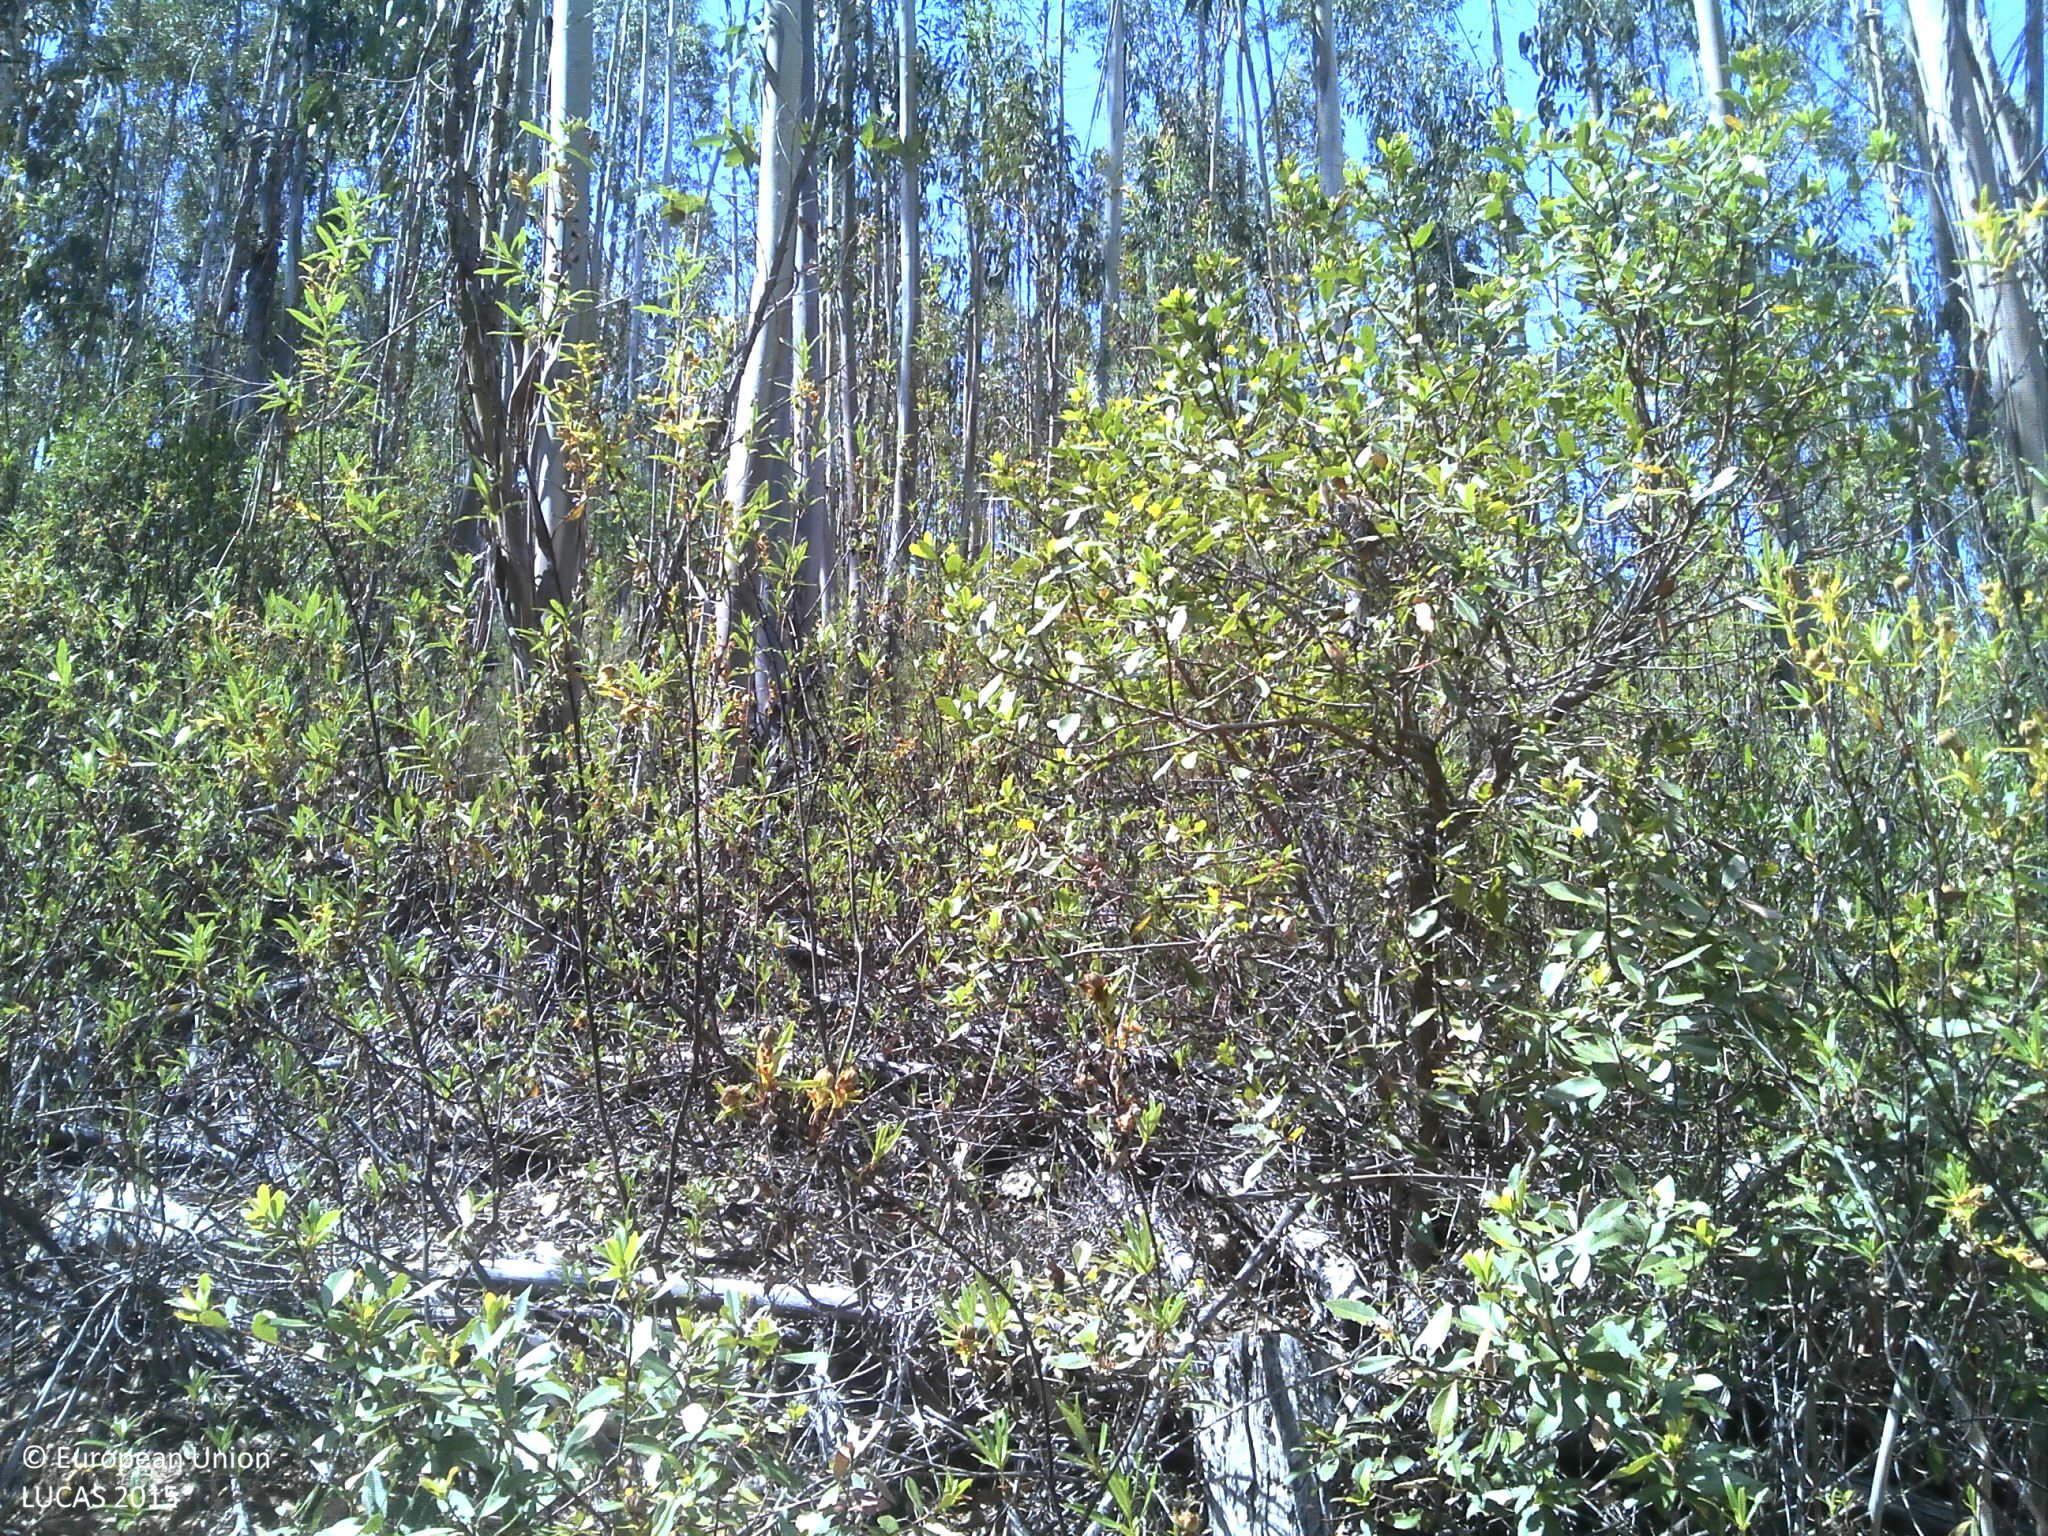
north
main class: Woodland
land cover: Broadleaved woodland
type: mesophytic deciduous forest
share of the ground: 50 - 75 %
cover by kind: broadleaved forest trees 70 %, shrubs 20 %, unconsolidated bare surface 10 %
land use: Forestry
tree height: > 5 m
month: July
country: PT
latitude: 39.9730
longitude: -7.8012
